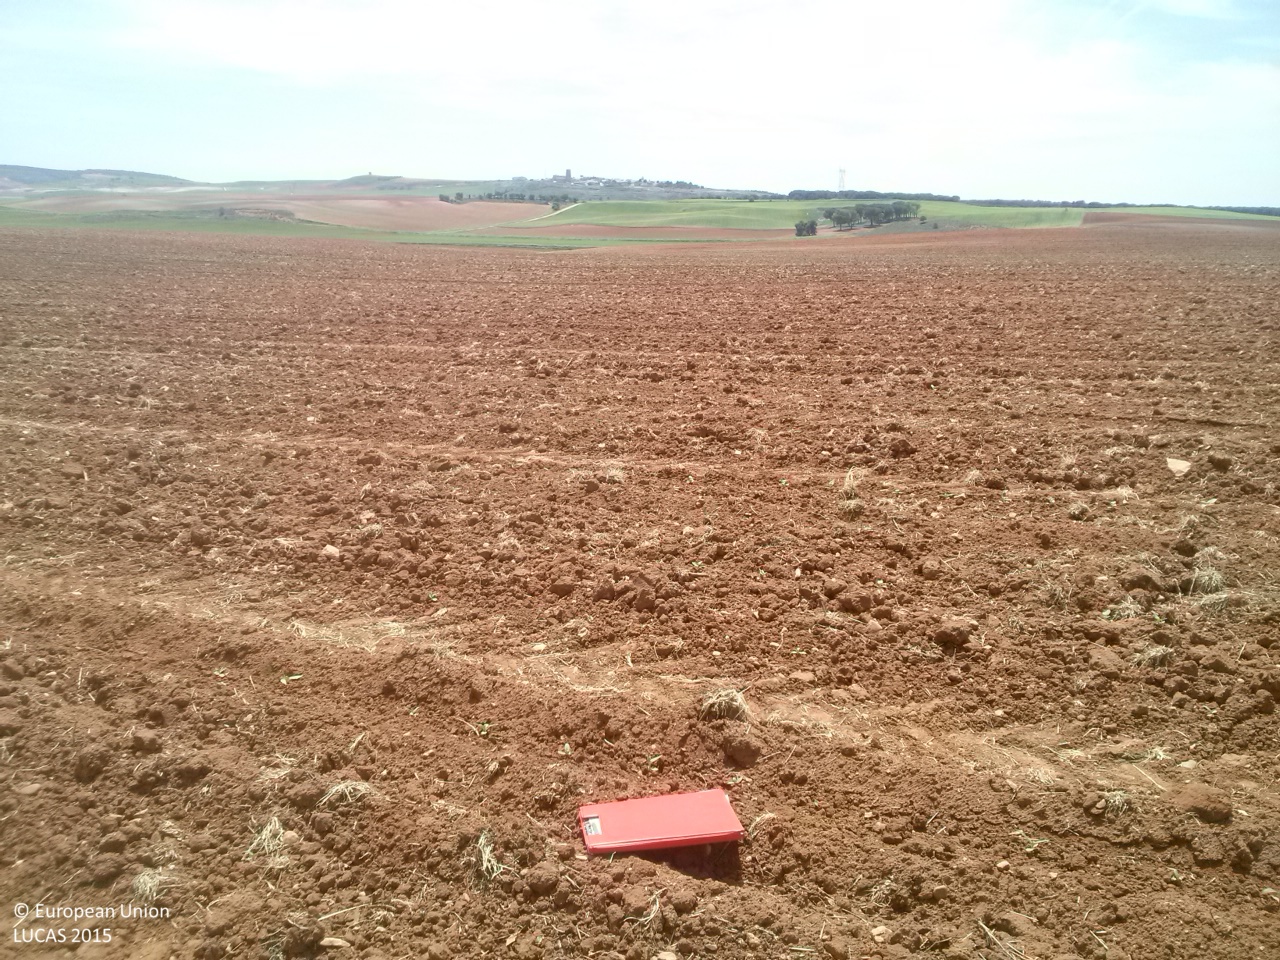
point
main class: Cropland
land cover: Sunflower
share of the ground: < 10 %
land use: Agriculture (excluding fallow land and kitchen gardens)
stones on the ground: 25 - 50 %
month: May
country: ES
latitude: 39.7580
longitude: -2.4929
